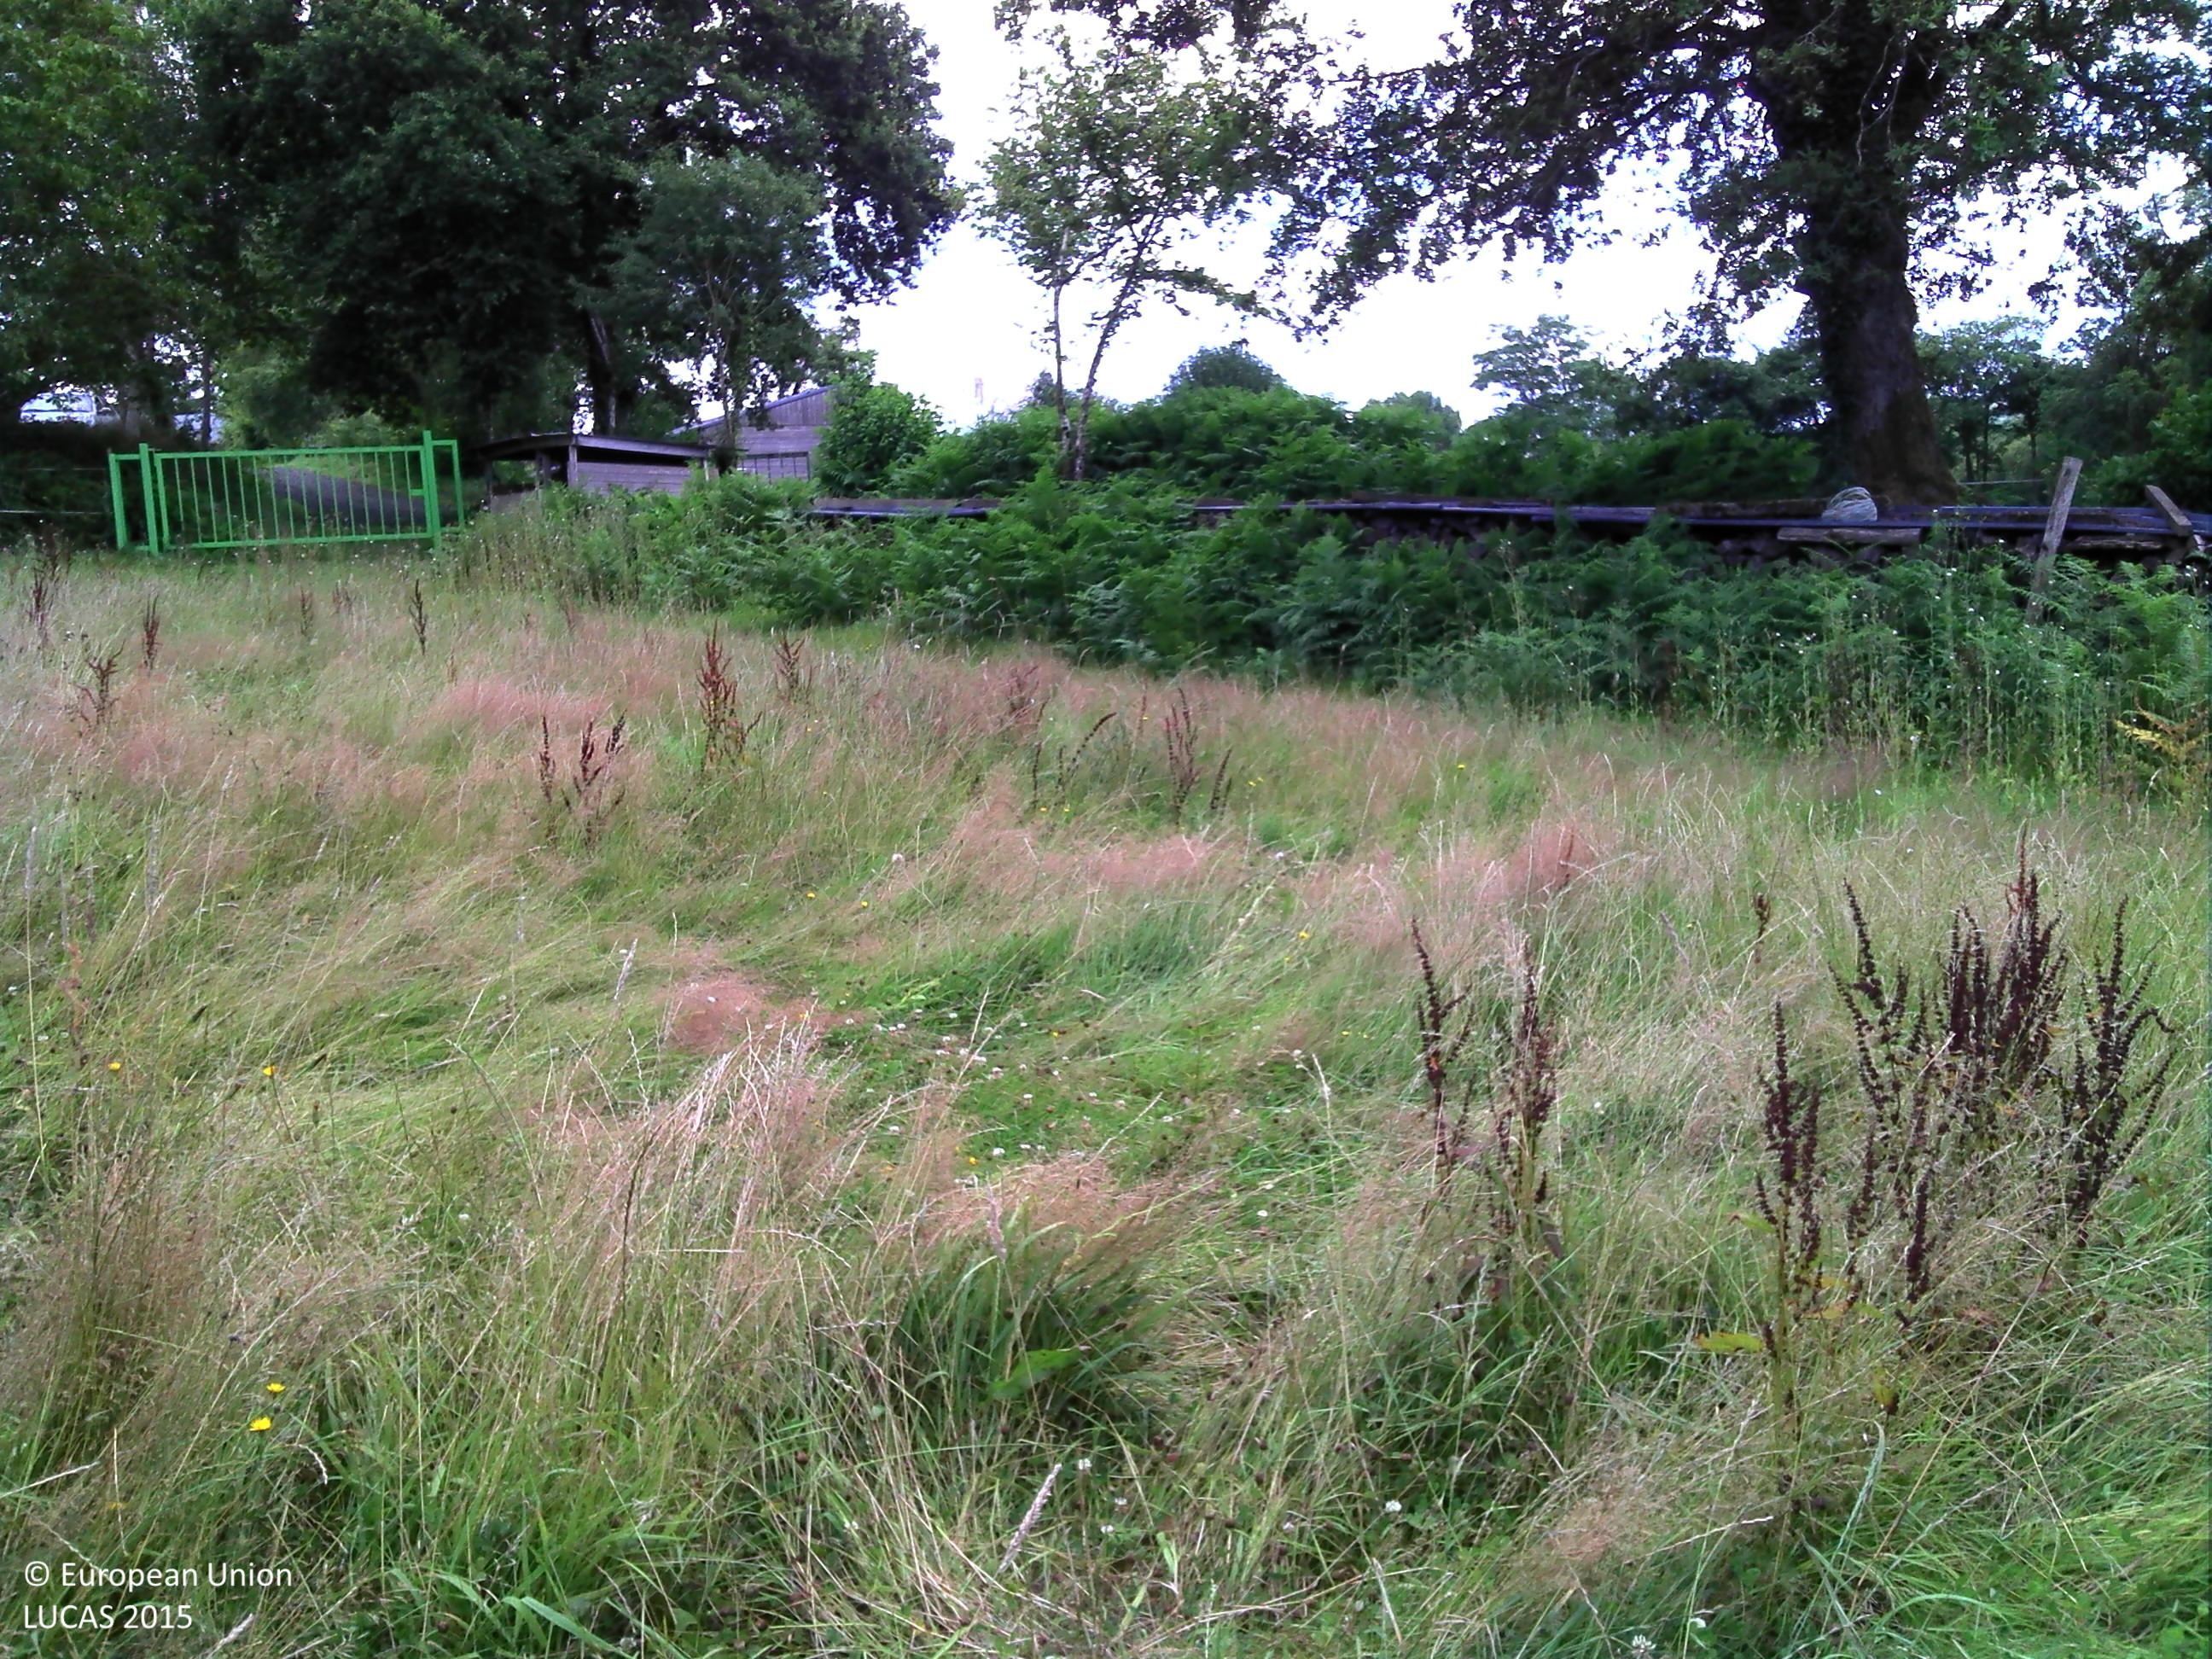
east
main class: Grassland
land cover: Grassland without tree/shrub cover
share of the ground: > 75 %
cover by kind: herbaceous plants 75 %, consolidated bare surface 20 %, shrubs 5 %
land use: Agriculture (excluding fallow land and kitchen gardens)
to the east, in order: Grassland without tree/shrub cover; Lines of trees; Tracks; Lines of trees; Grassland without tree/shrub cover; Fences; Lines of trees; Grass margins; Tracks; Grass margins; Fences; Grassland without tree/shrub cover; Artificial constructions in urban areas; Spontaneously vegetated surfaces; Apple fruit
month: July
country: FR
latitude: 47.8664
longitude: -3.0212
